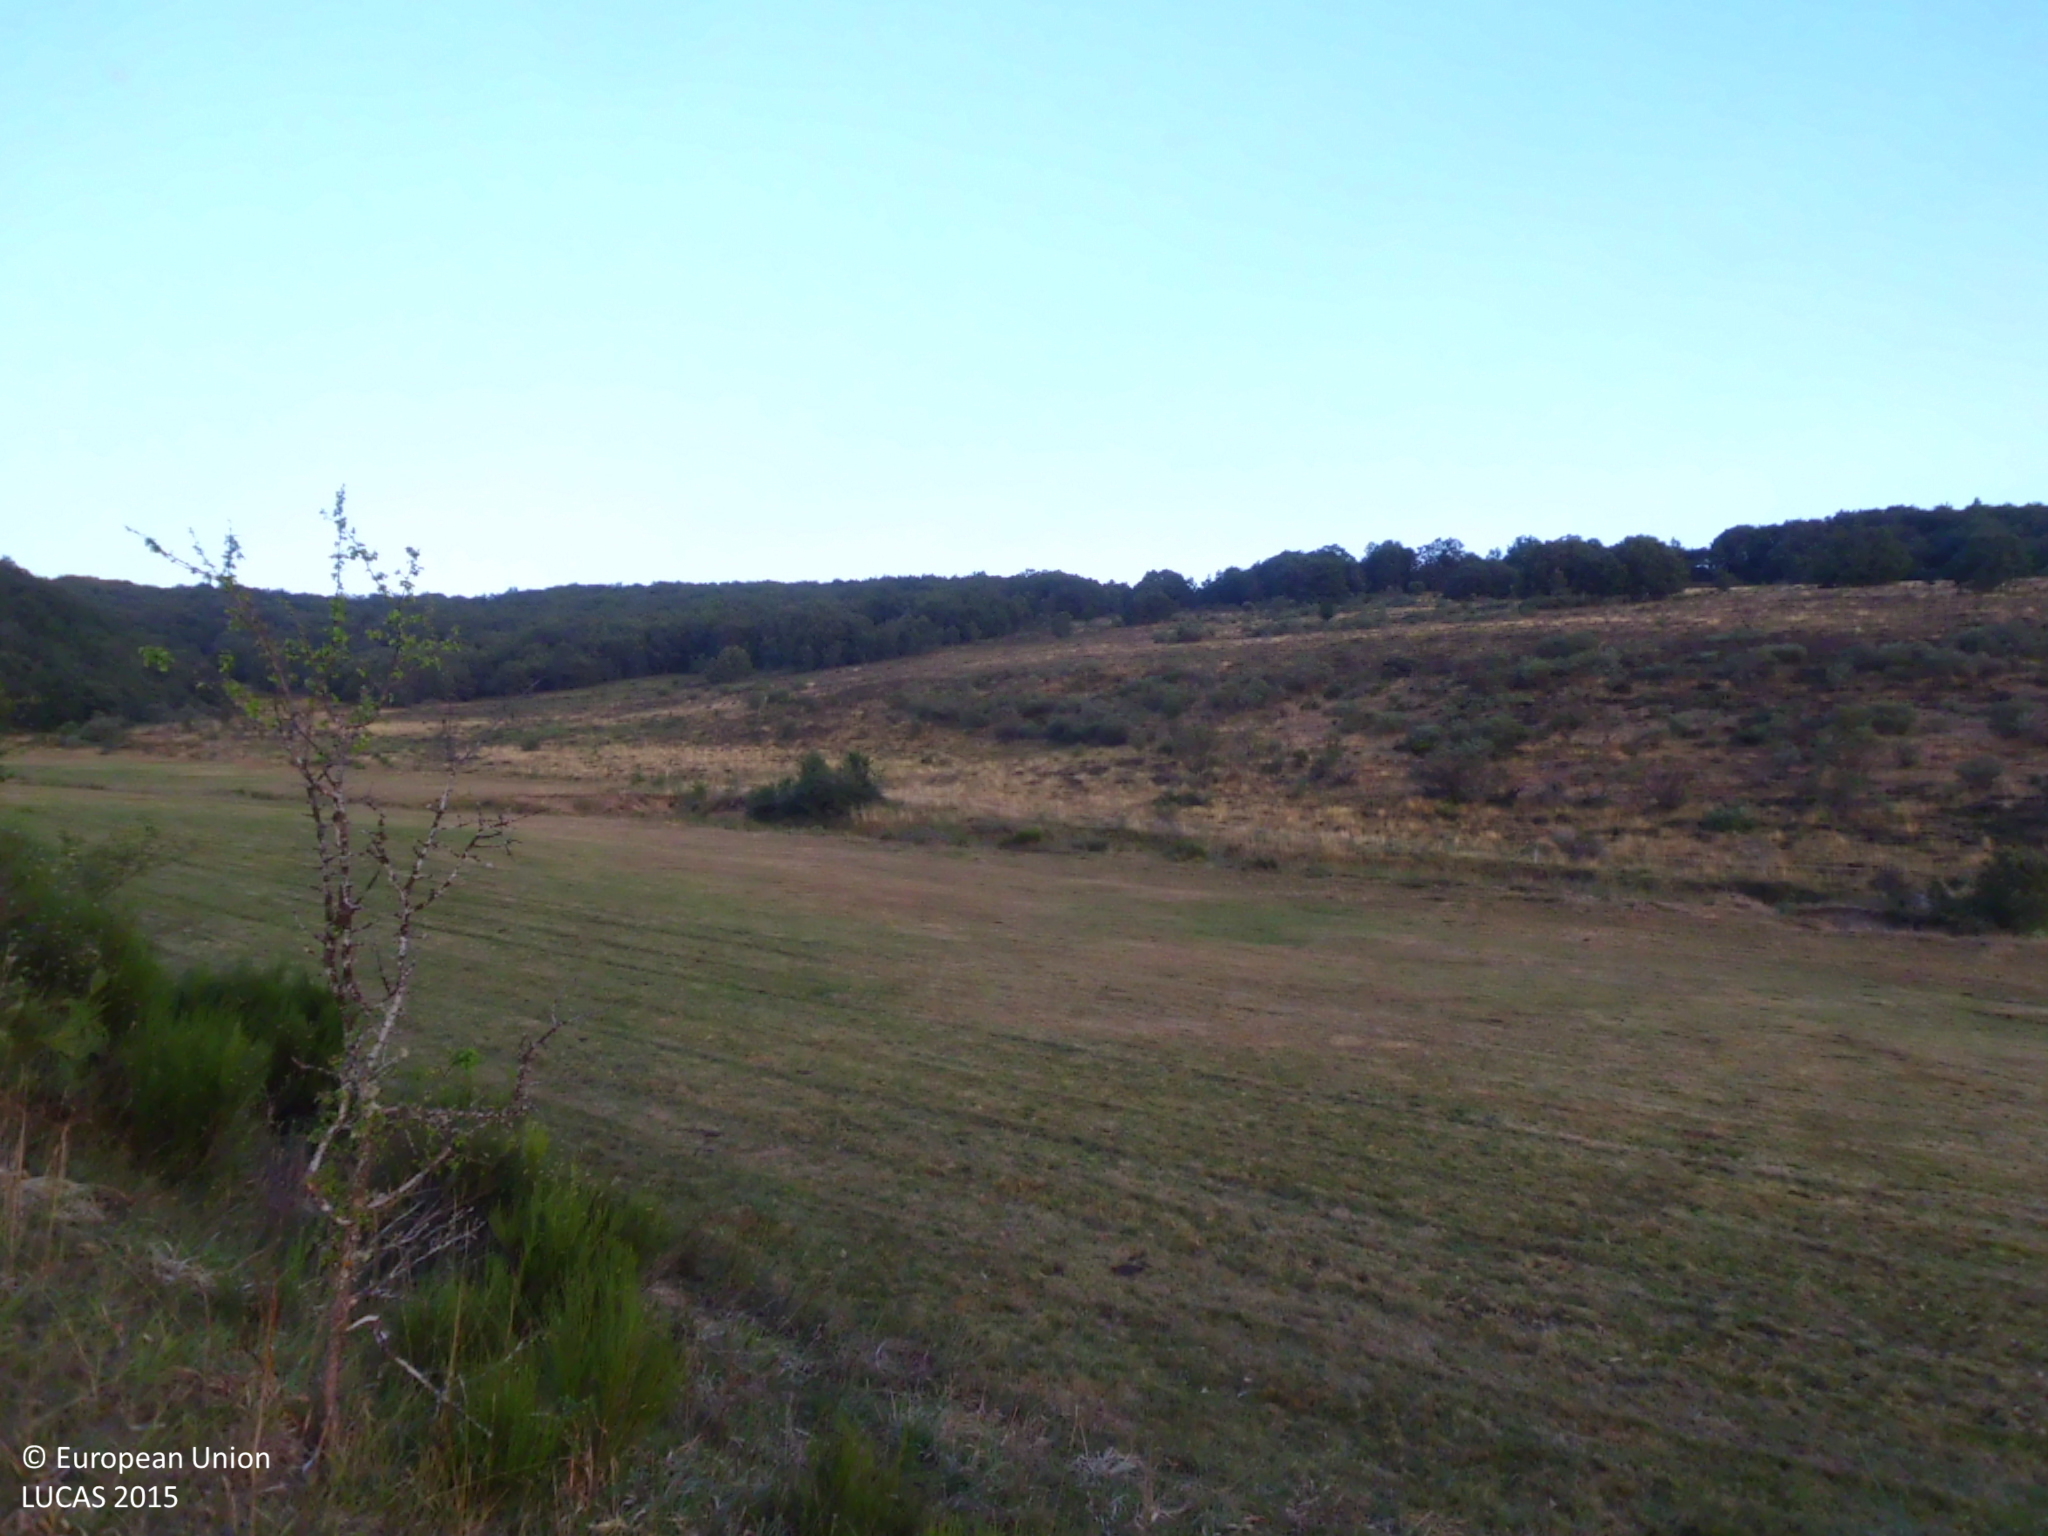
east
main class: Grassland
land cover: Grassland without tree/shrub cover
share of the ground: > 75 %
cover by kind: herbaceous plants 100 %
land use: Agriculture (excluding fallow land and kitchen gardens)
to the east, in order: Grassland without tree/shrub cover
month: July
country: ES
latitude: 42.9334
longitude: -4.4278
